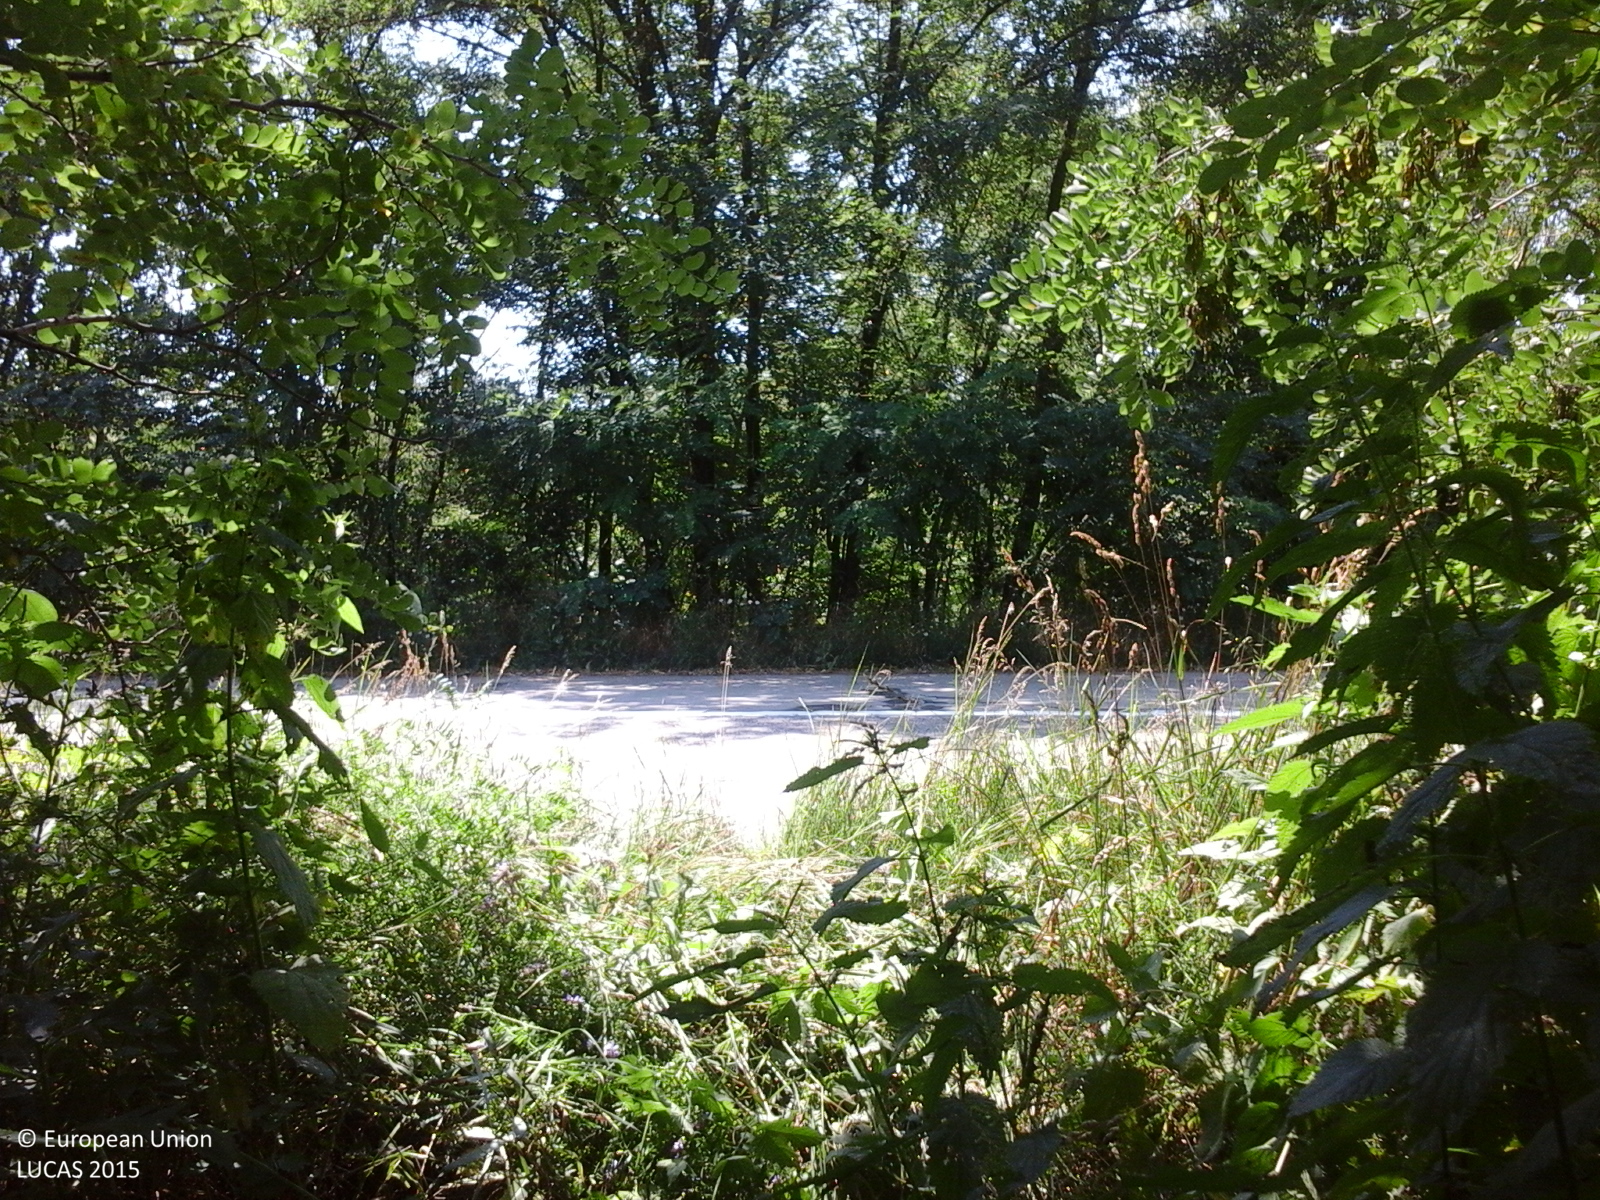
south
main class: Woodland
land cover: Broadleaved woodland
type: thermophilous deciduous forest
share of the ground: > 75 %
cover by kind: broadleaved forest trees 100 %
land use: Forestry
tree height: > 5 m
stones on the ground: < 10 %
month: July
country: RO
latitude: 44.7833
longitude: 24.5453
